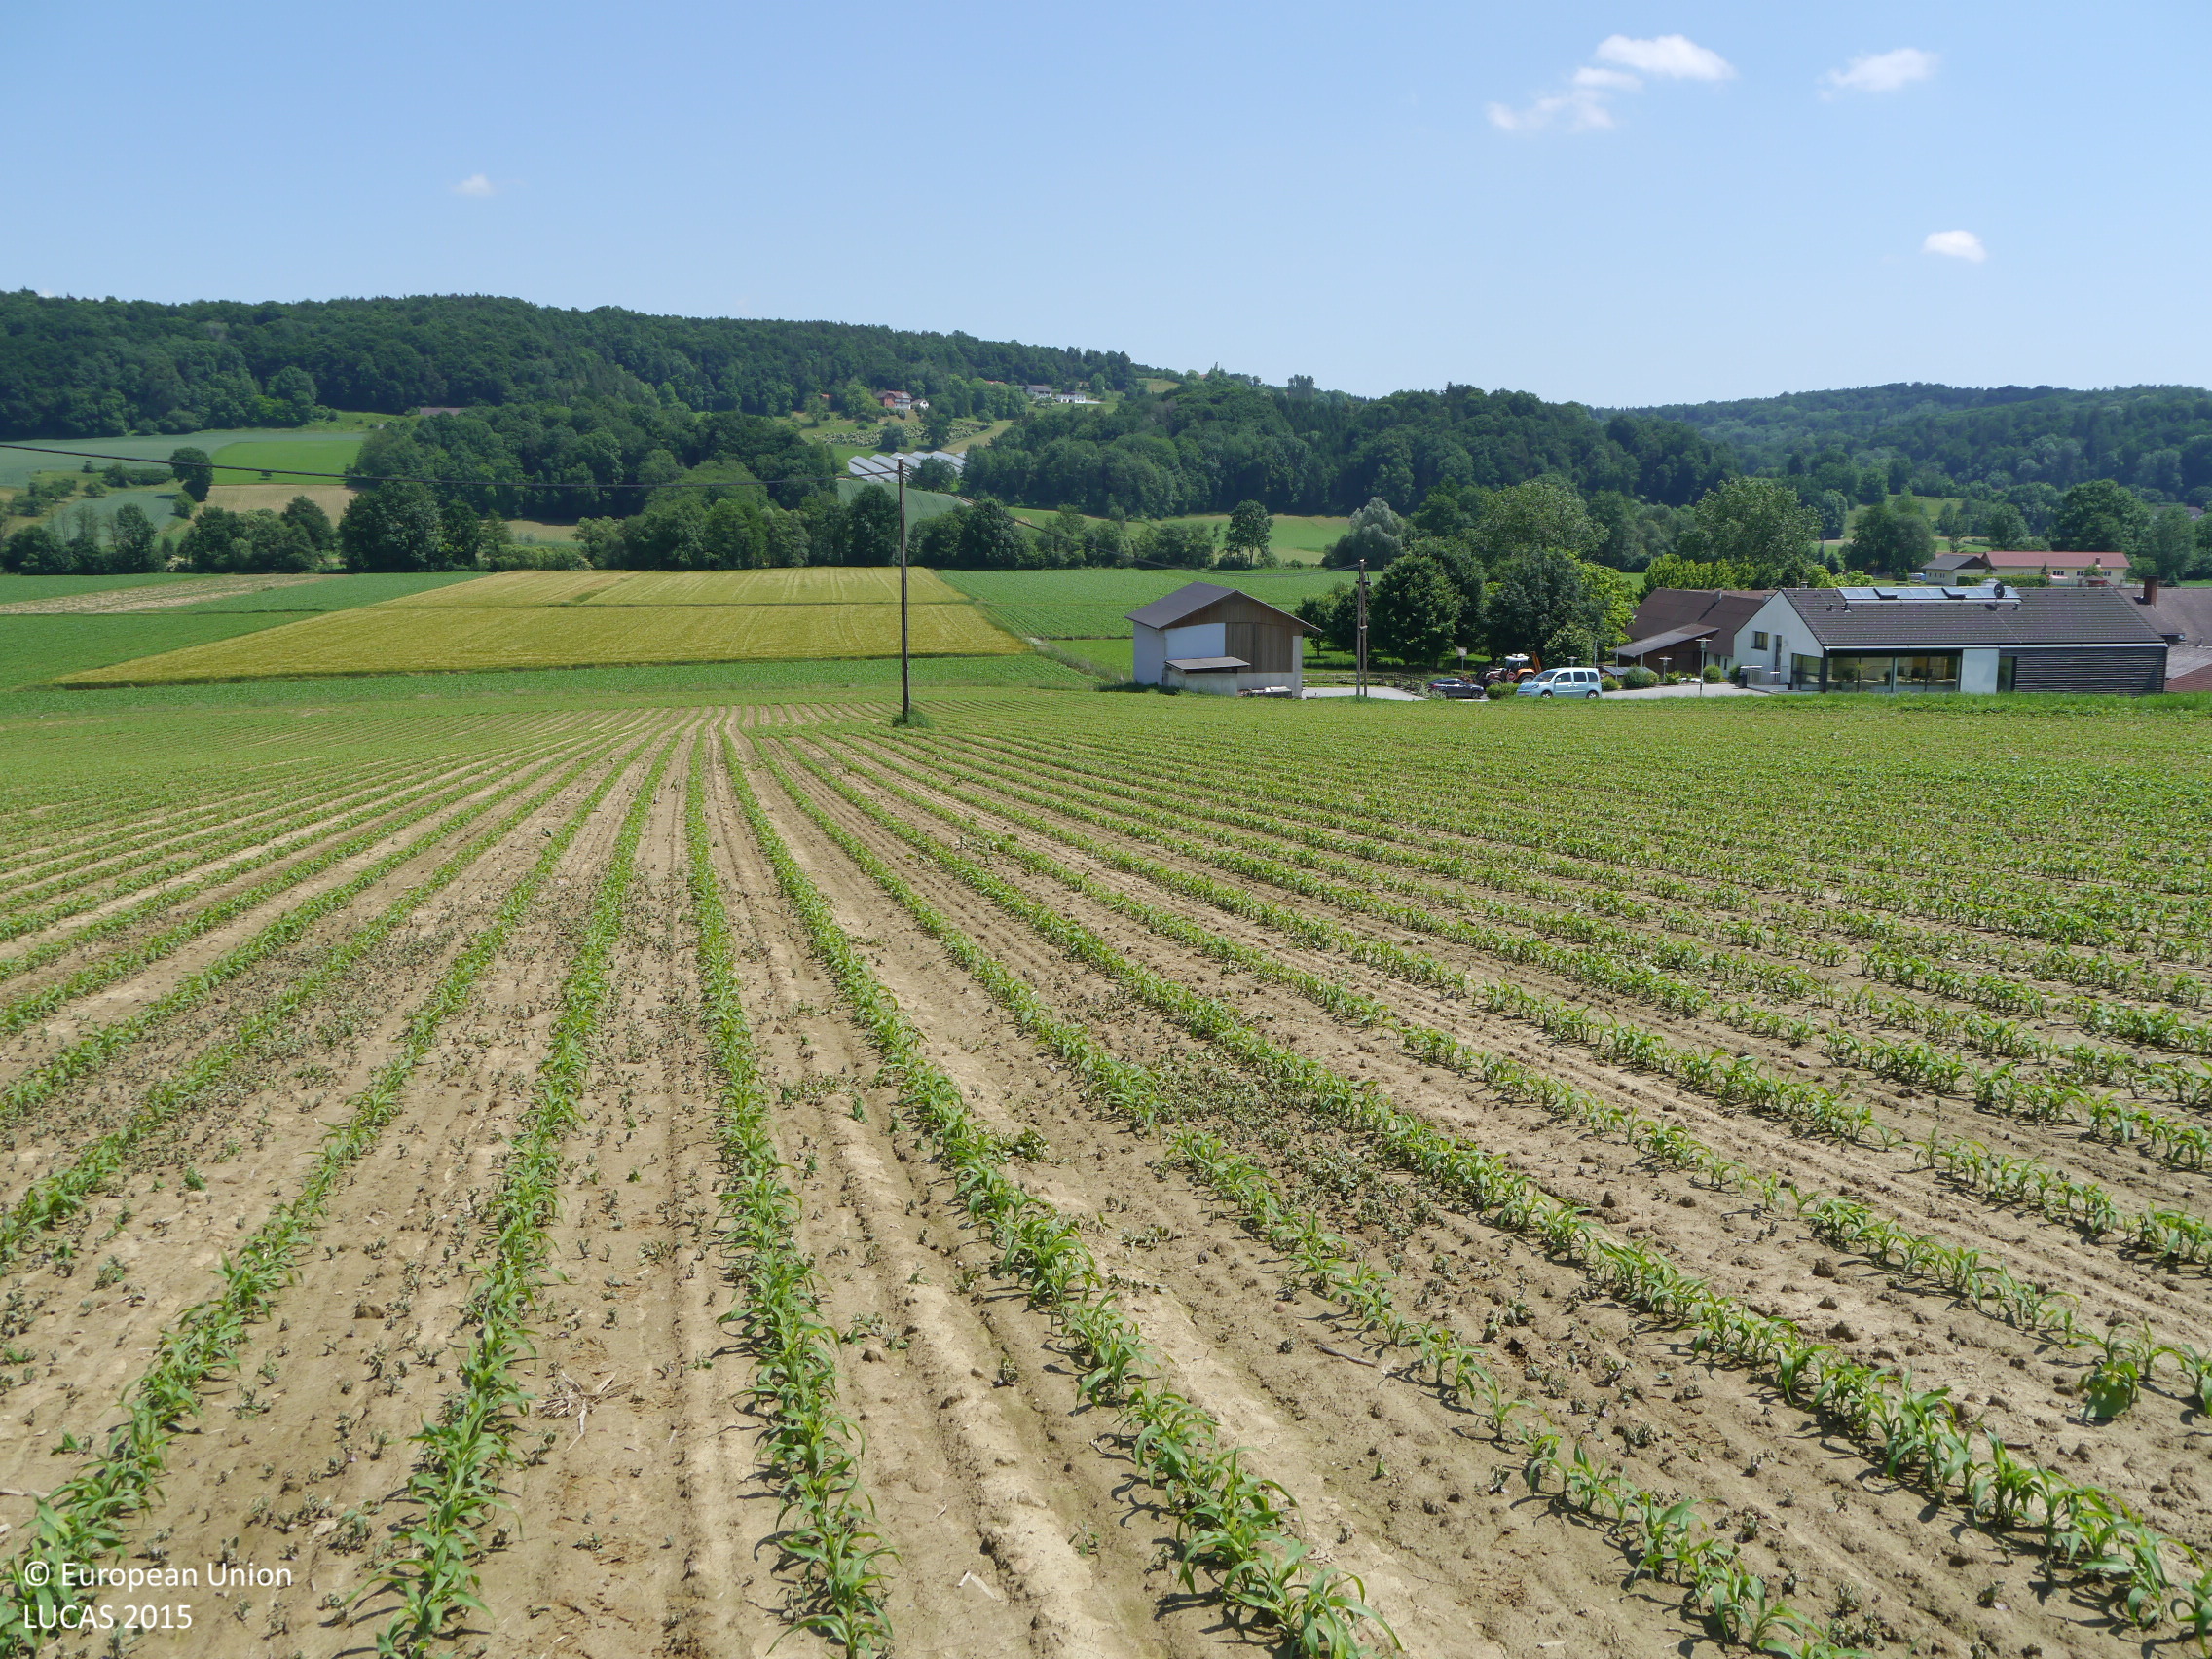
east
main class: Cropland
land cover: Maize
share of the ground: 25 - 50 %
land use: Agriculture (excluding fallow land and kitchen gardens)
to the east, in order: Maize; Electric lines; Maize; Grassland without tree/shrub cover; Ditches and canals; Paved roads, cycling and walking lanes; Grass margins; Maize; Barley
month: June
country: AT
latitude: 46.8696
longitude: 15.6543
